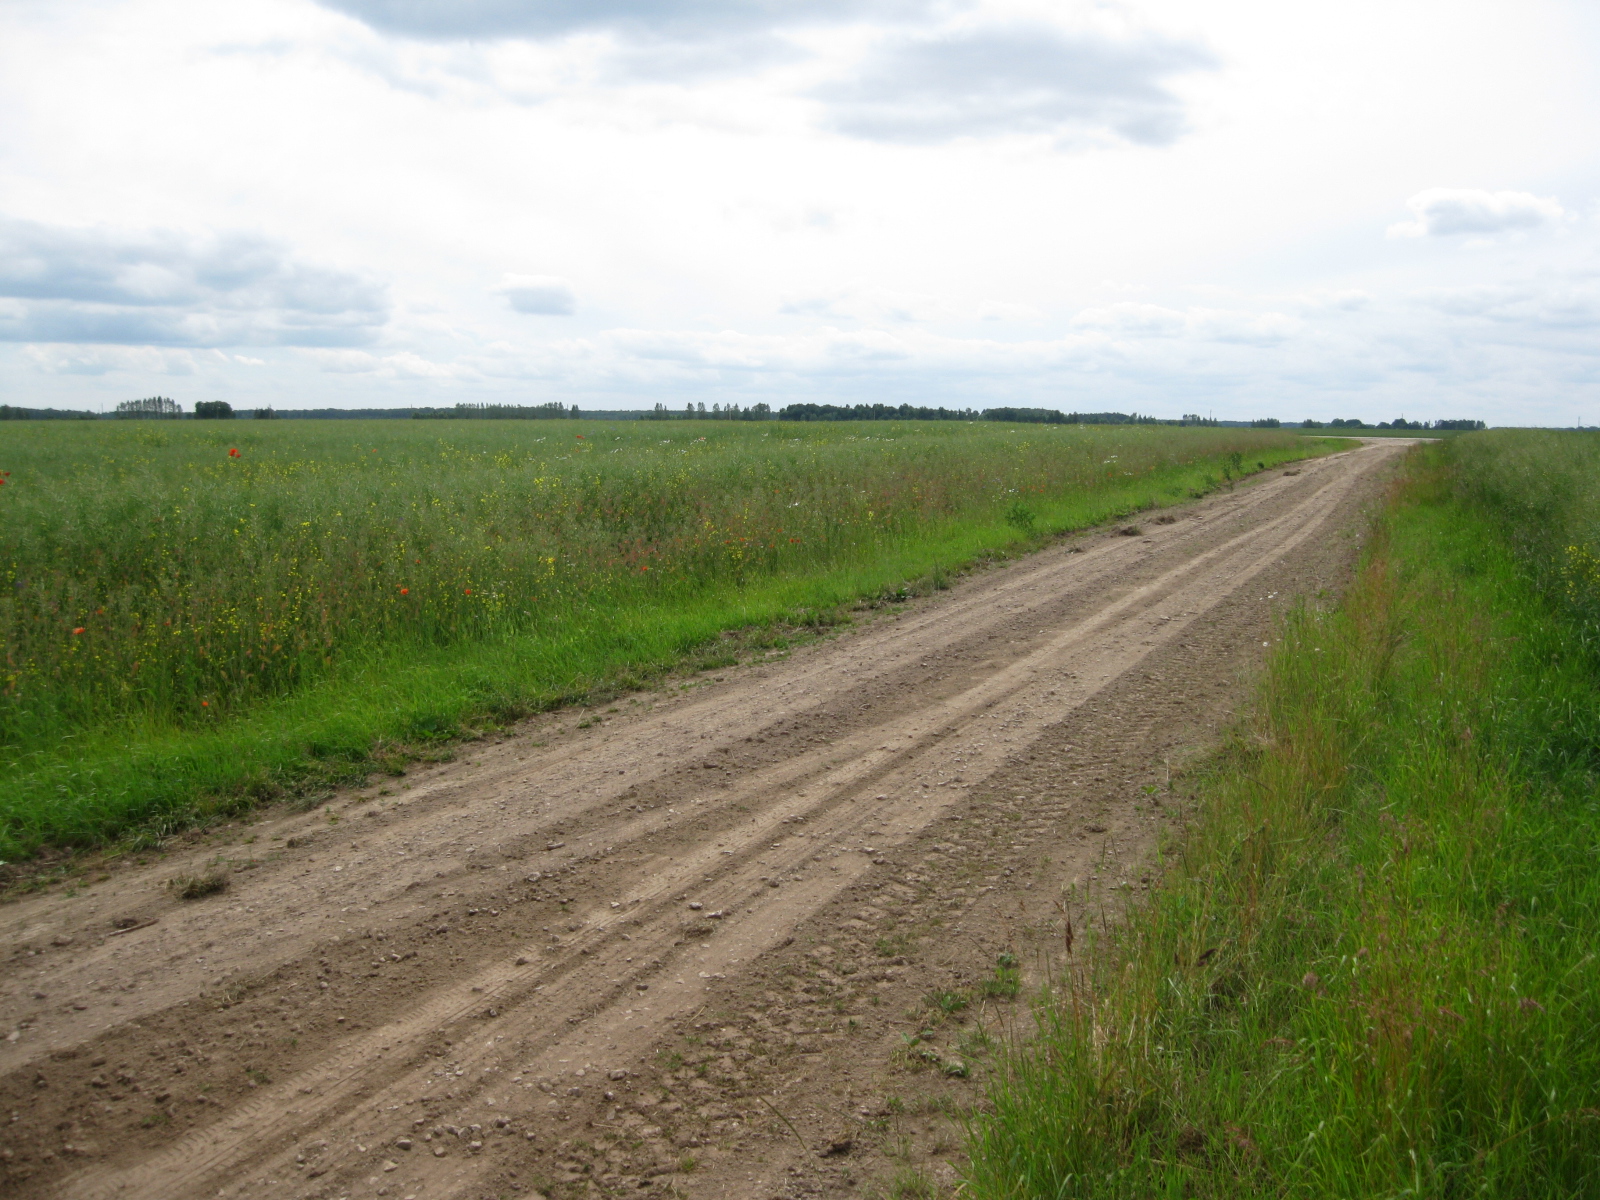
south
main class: Cropland
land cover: Rape and turnip rape
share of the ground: > 75 %
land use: Agriculture (excluding fallow land and kitchen gardens)
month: June
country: LT
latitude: 55.6076
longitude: 24.2377
